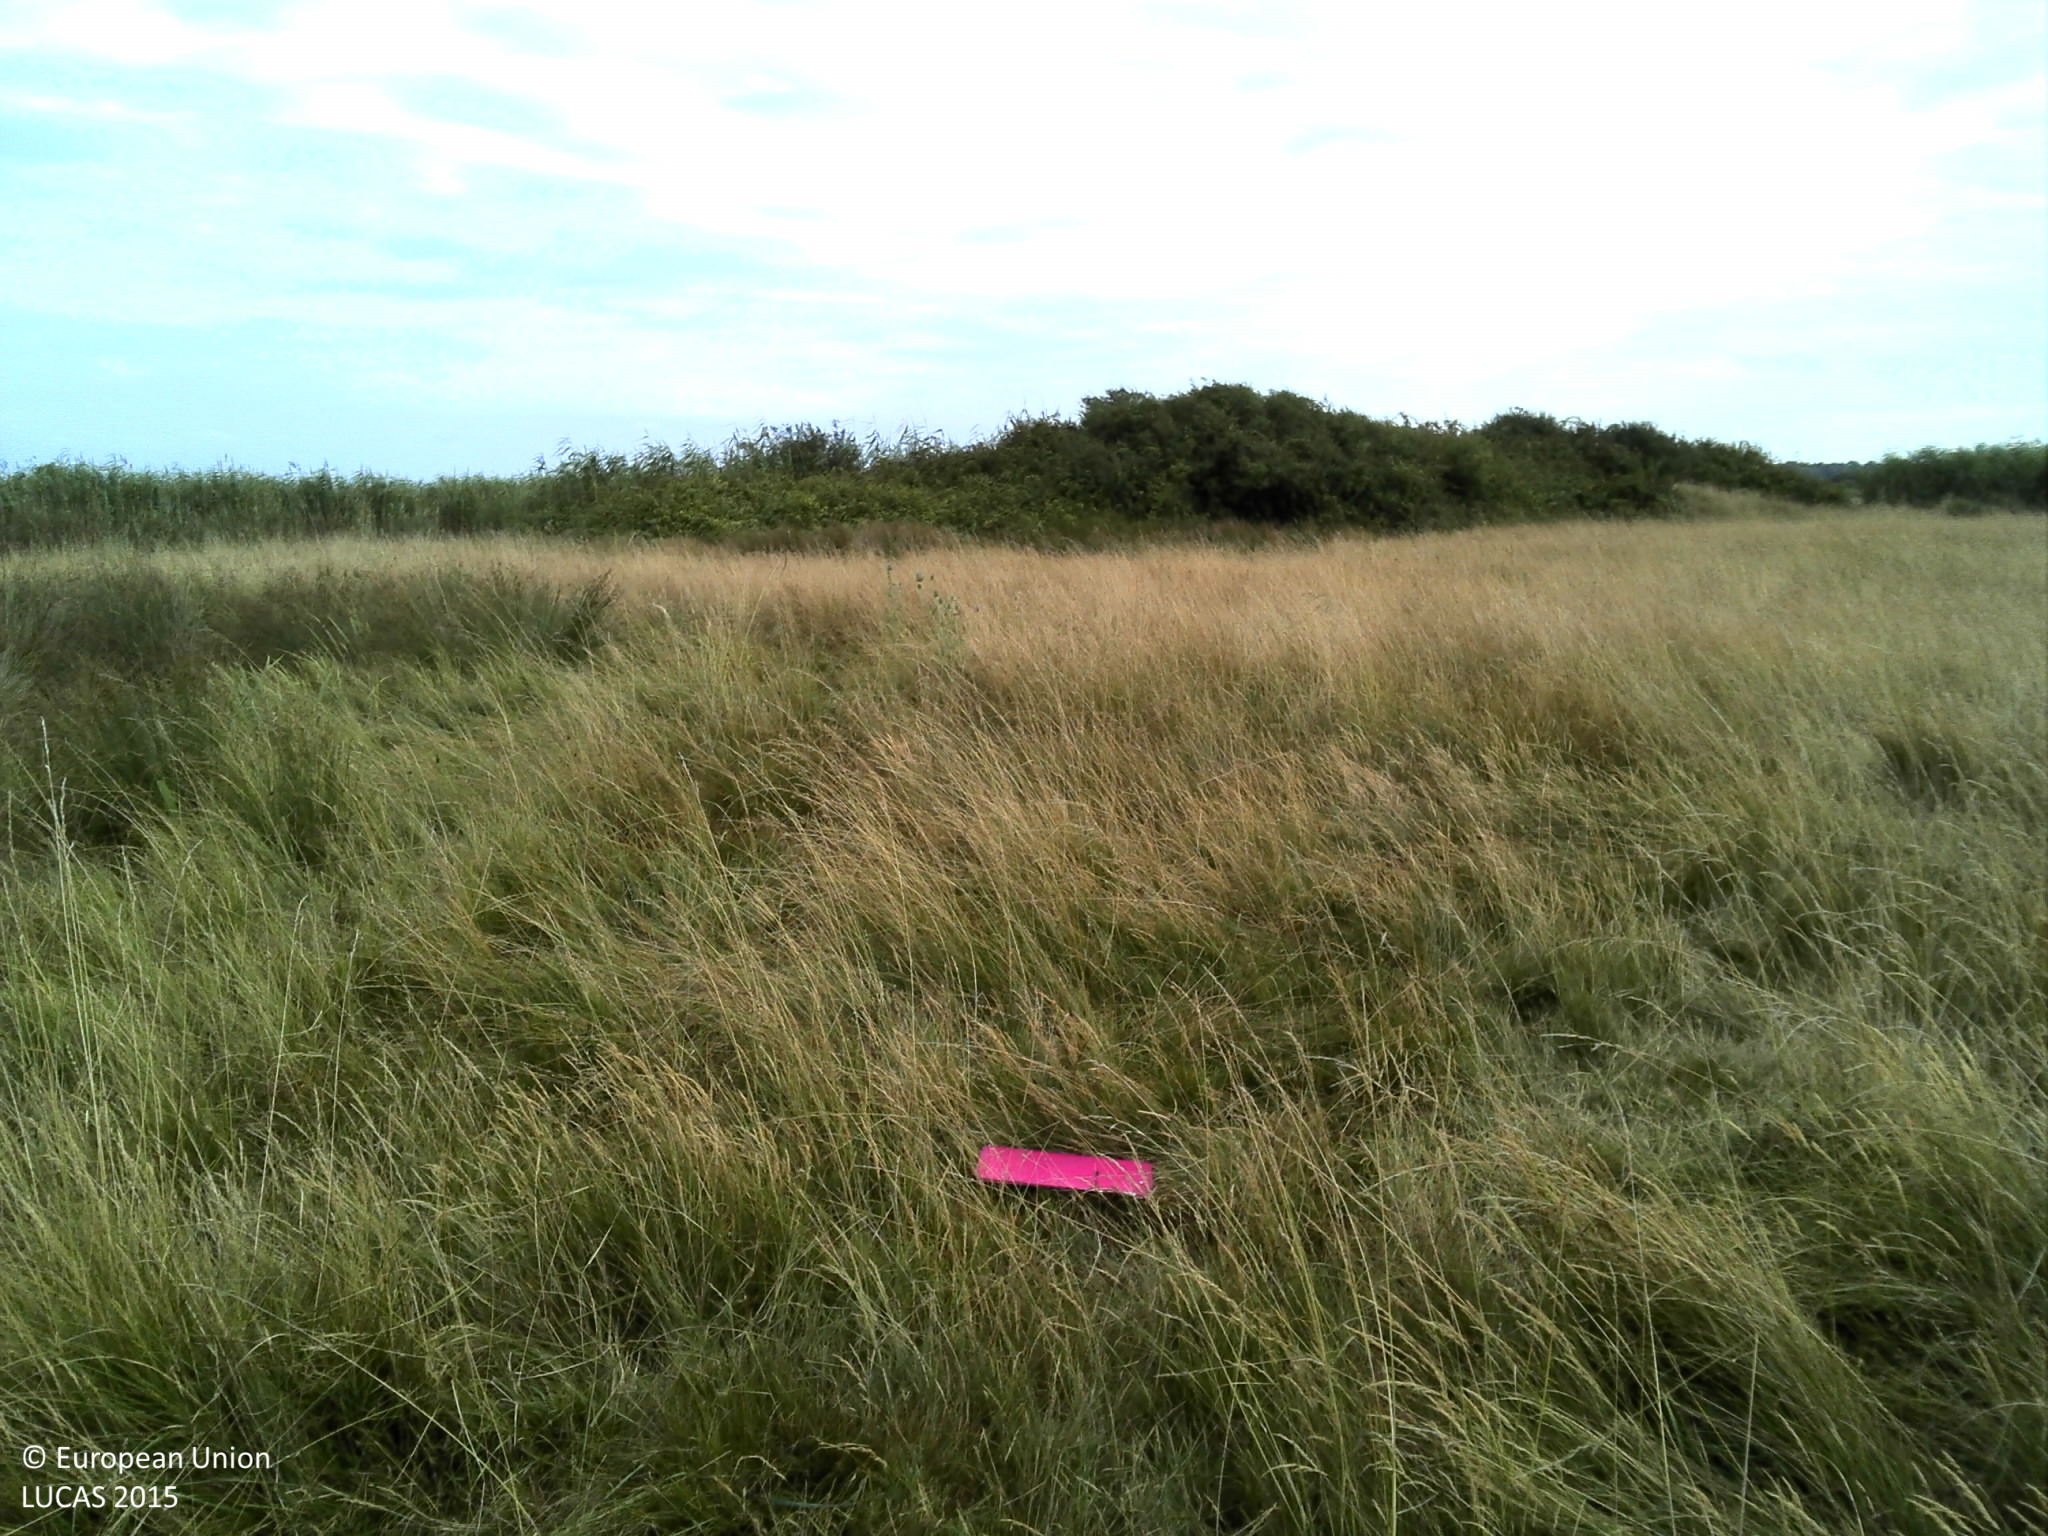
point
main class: Grassland
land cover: Grassland without tree/shrub cover
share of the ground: > 75 %
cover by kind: herbaceous plants 100 %
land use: Agriculture (excluding fallow land and kitchen gardens)
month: July
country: FR
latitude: 45.4992
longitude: -1.0975
